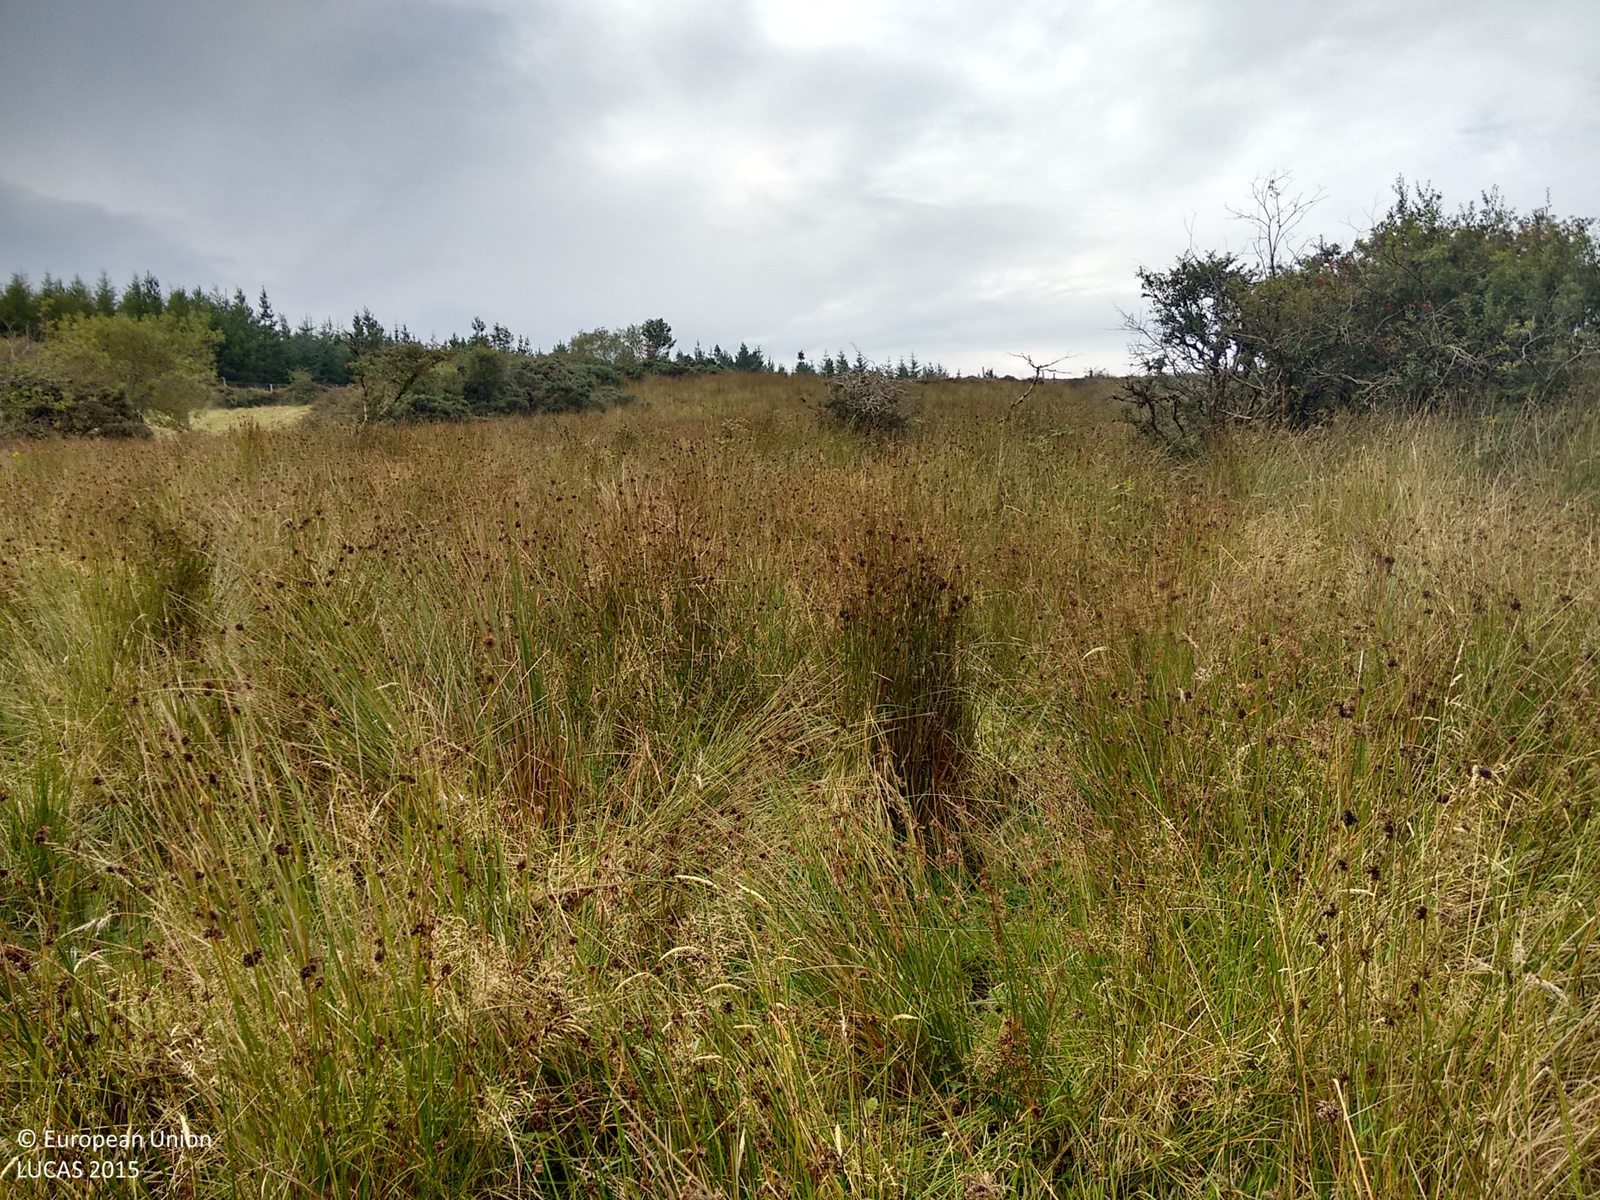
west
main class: Grassland
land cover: Grassland with sparse tree/shrub cover
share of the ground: > 75 %
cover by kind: herbaceous plants 85 %, shrubs 10 %, broadleaved forest trees 5 %
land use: Agriculture (excluding fallow land and kitchen gardens)
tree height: < 5 m
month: September
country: IE
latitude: 53.9250
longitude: -9.2731
